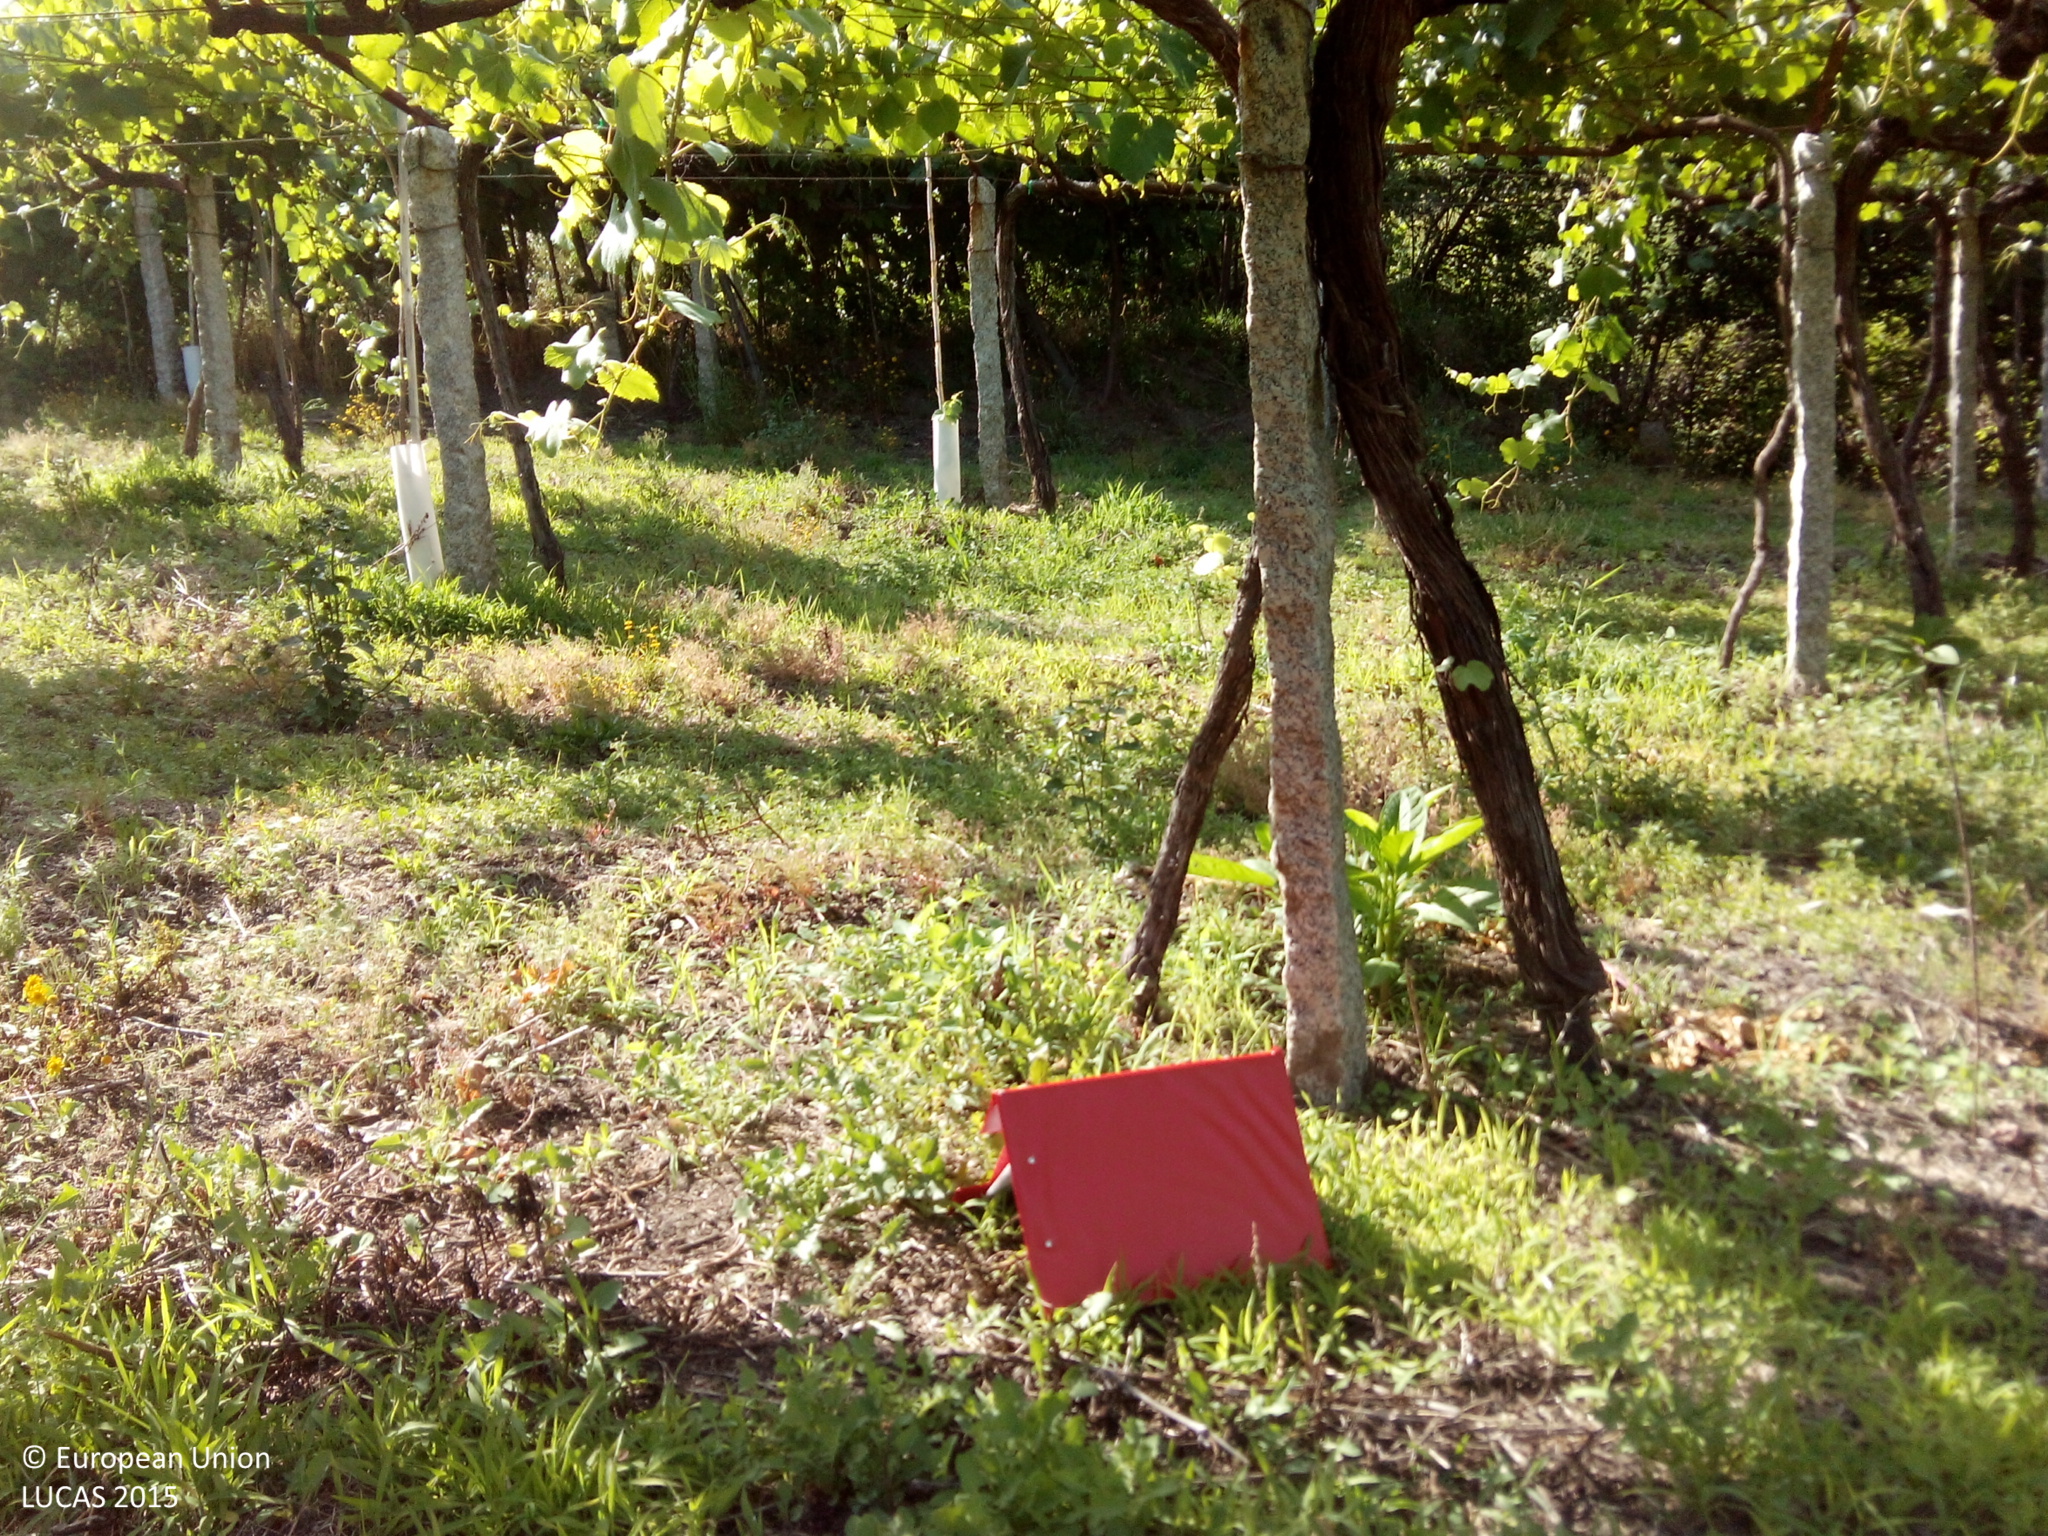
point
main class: Cropland
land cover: Vineyards
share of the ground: > 75 %
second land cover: Grassland without tree/shrub cover
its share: > 75 %
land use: Agriculture (excluding fallow land and kitchen gardens)
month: June
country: ES
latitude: 42.1083
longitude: -8.3364
